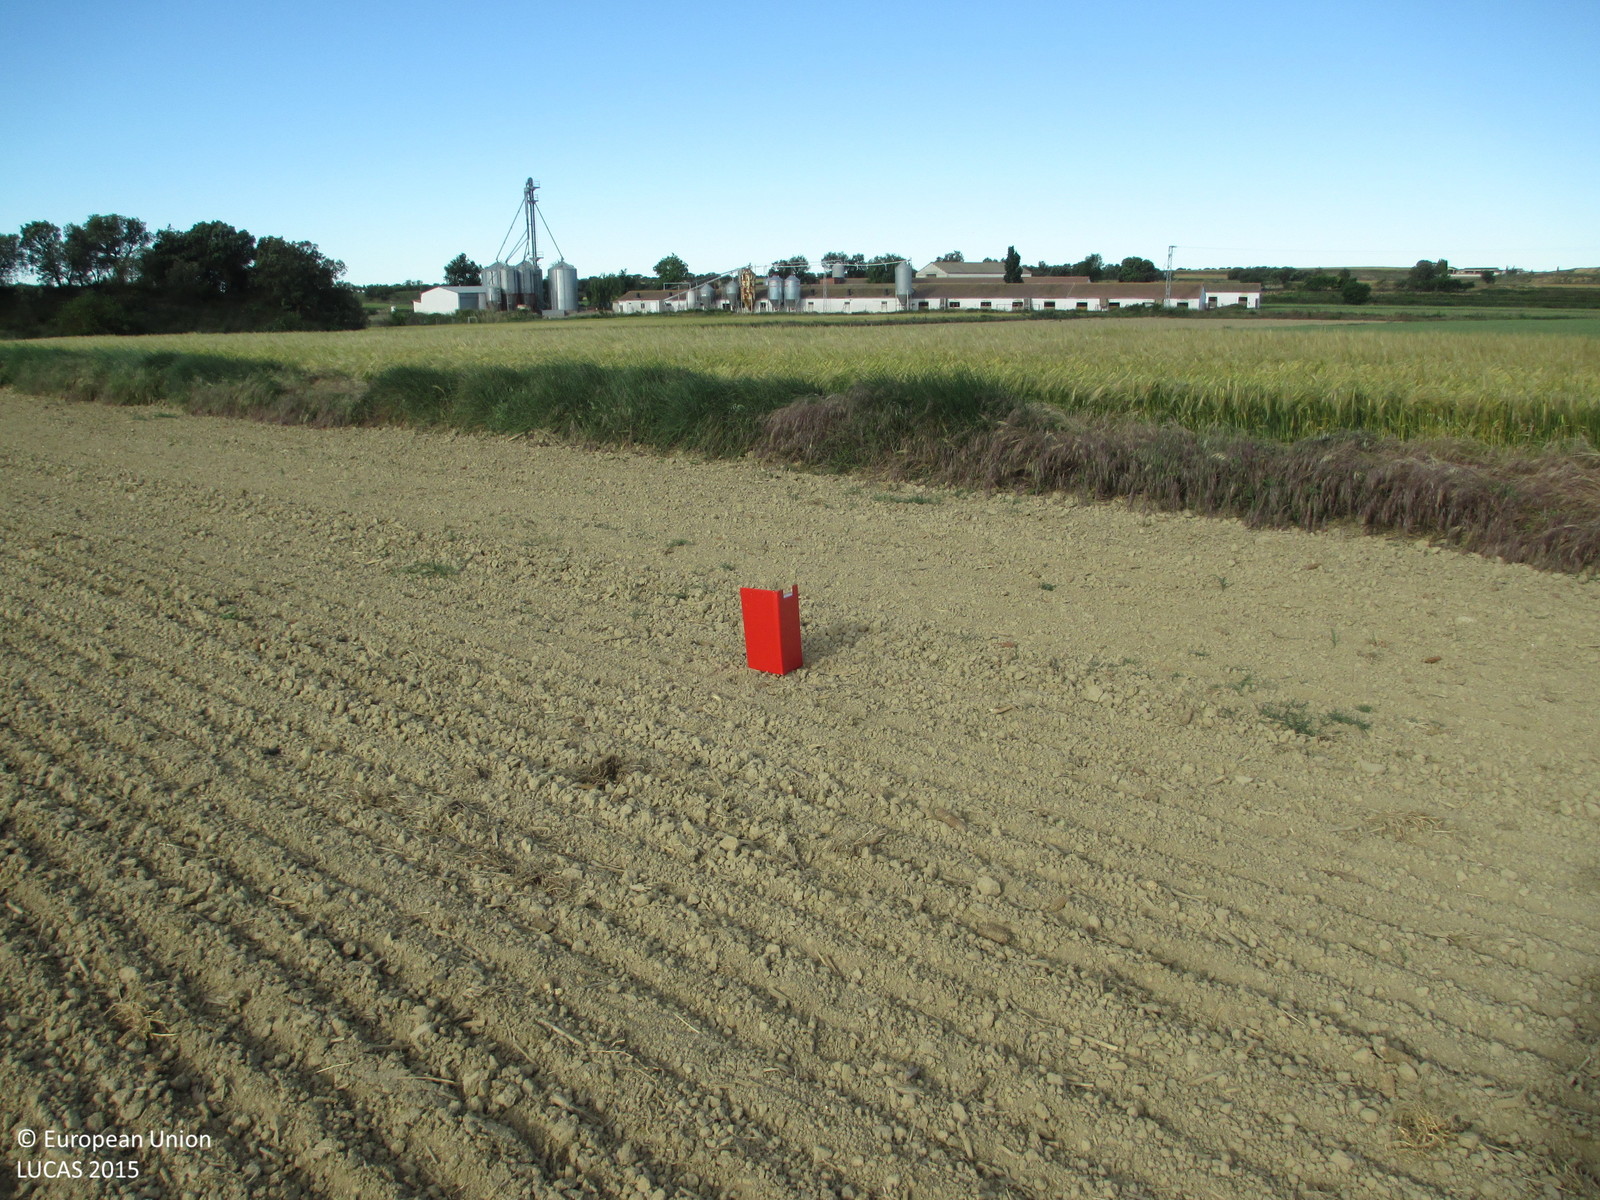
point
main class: Cropland
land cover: Maize
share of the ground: < 10 %
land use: Agriculture (excluding fallow land and kitchen gardens)
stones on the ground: < 10 %
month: May
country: ES
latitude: 42.0747
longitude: -0.2830
